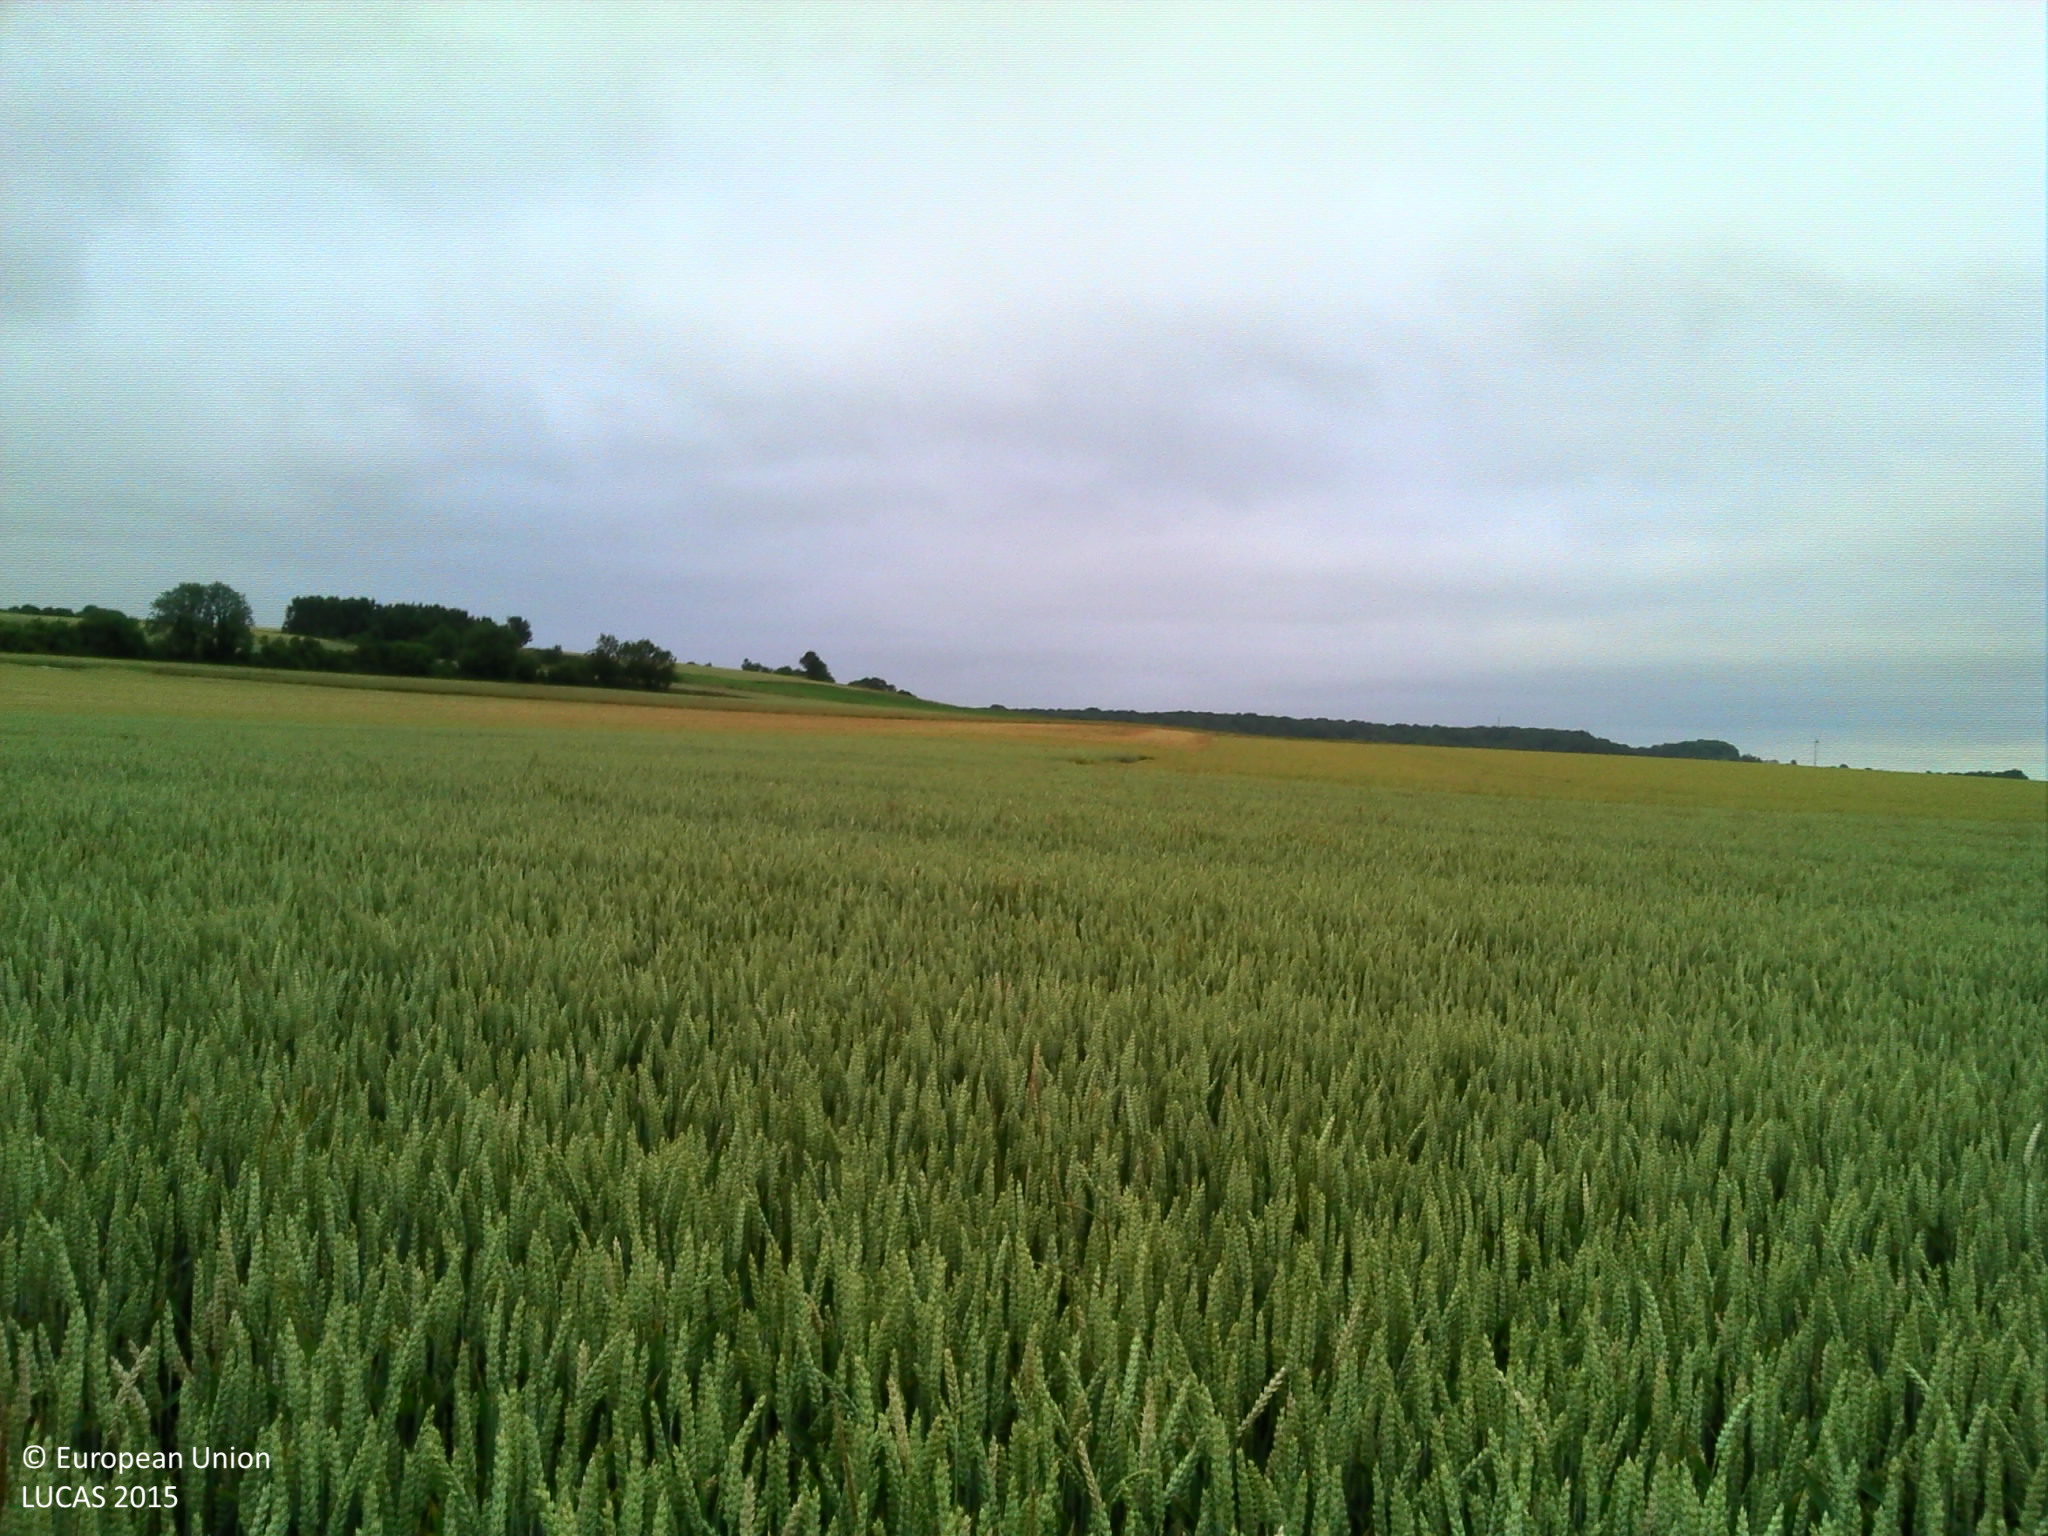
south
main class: Cropland
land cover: Common wheat
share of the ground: > 75 %
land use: Agriculture (excluding fallow land and kitchen gardens)
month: June
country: FR
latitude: 49.6169
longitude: 2.3050
